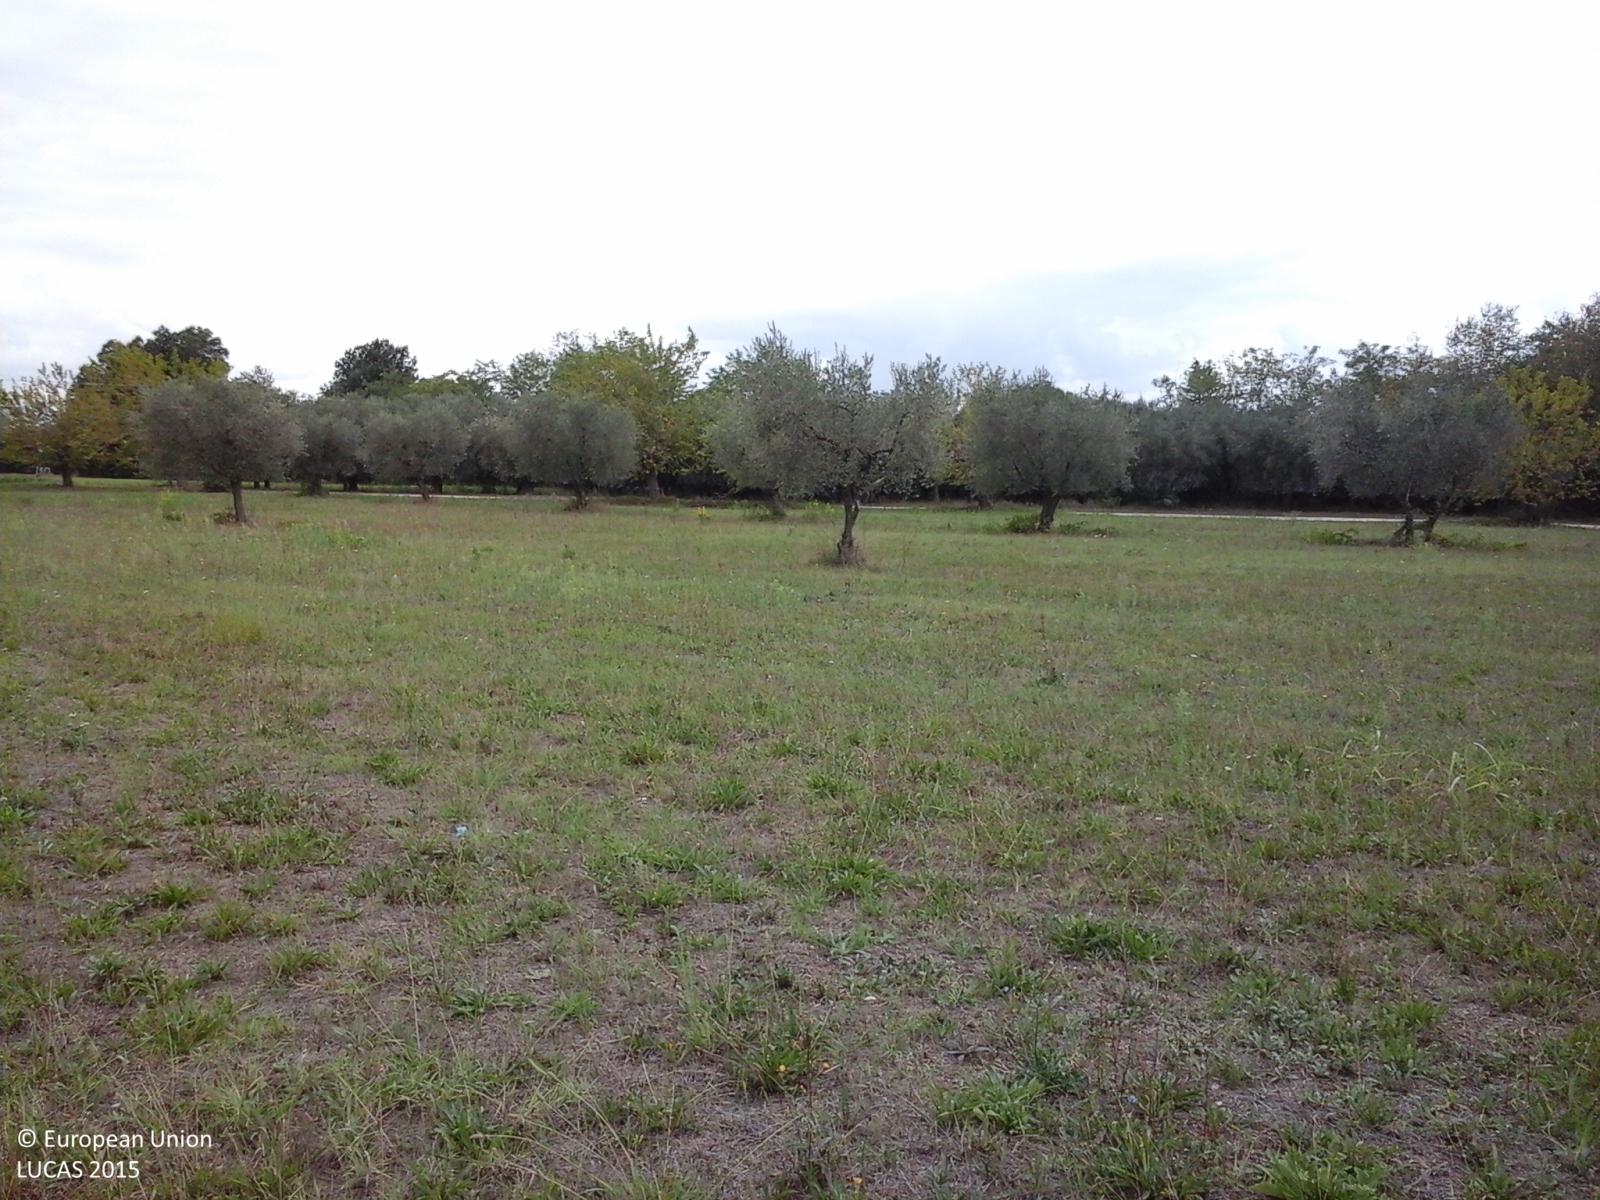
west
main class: Cropland
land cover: Olive groves
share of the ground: < 10 %
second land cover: Spontaneously vegetated surfaces
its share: > 75 %
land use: Agriculture (excluding fallow land and kitchen gardens)
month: September
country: IT
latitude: 42.7991
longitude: 13.8163
